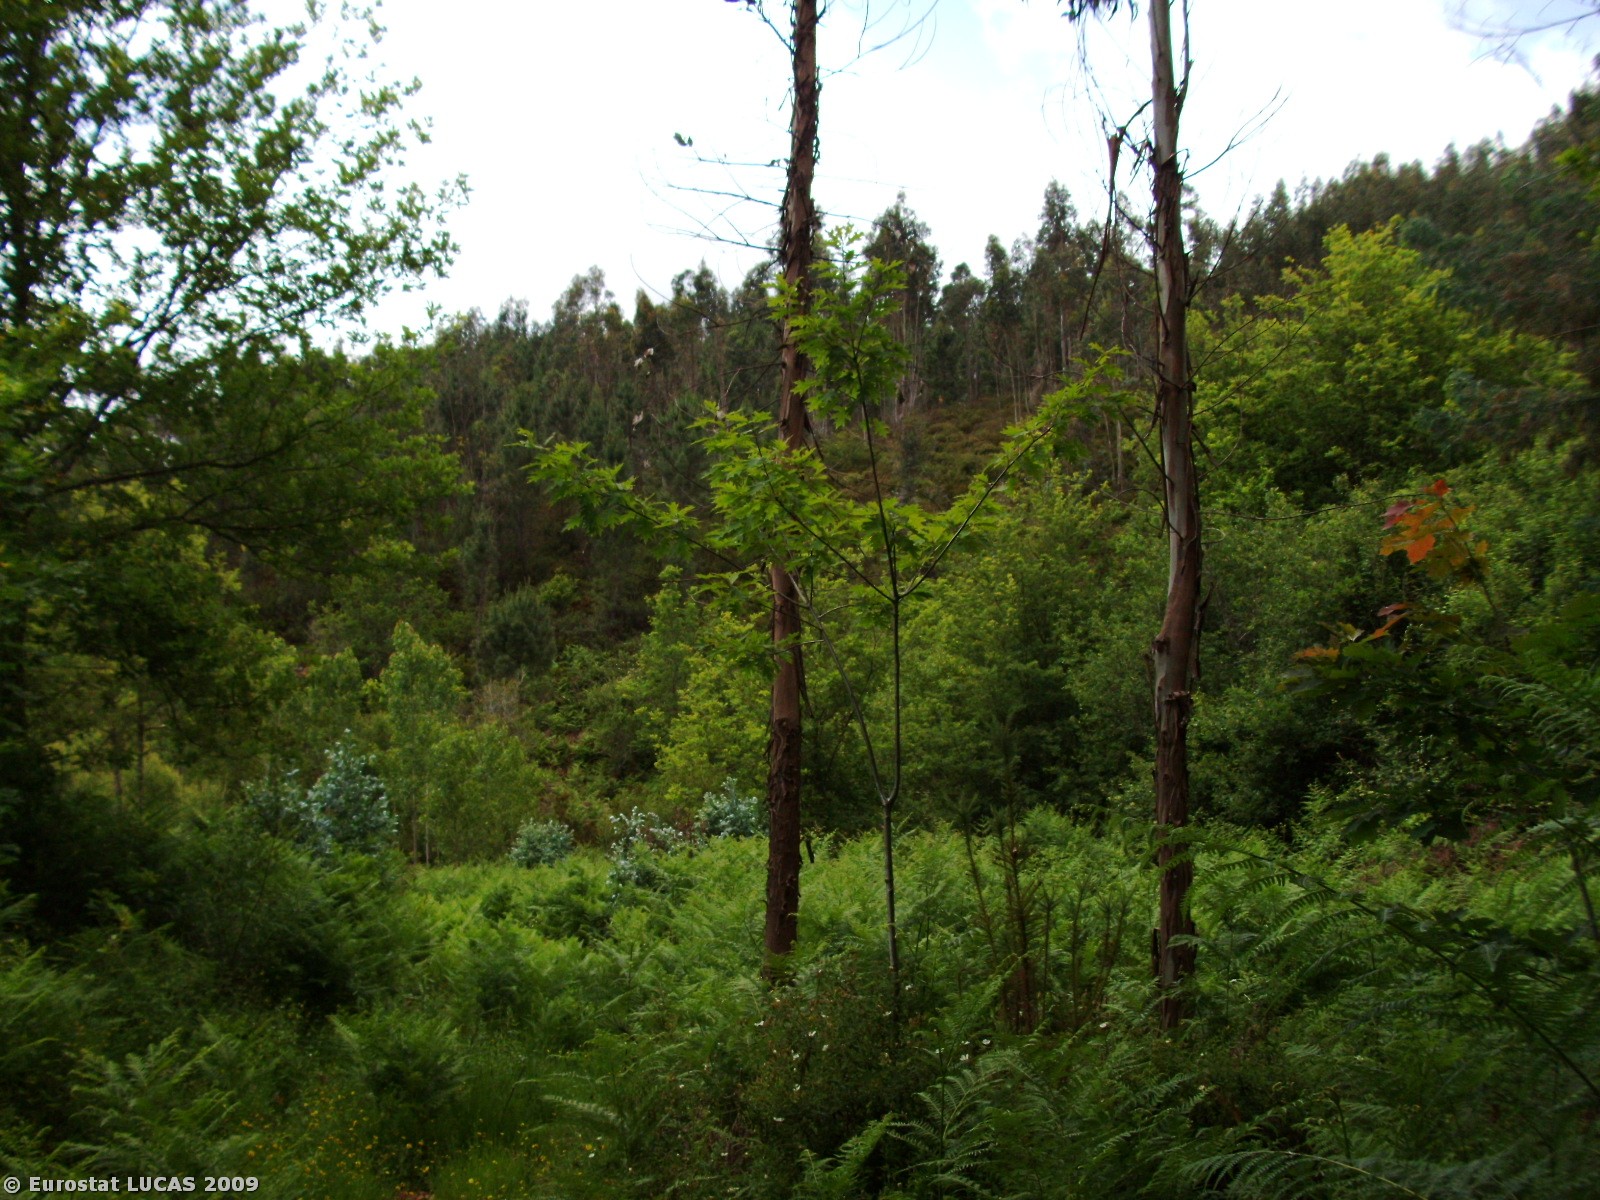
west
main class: Woodland
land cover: Broadleaved woodland
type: mesophytic deciduous forest
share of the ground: 50 - 75 %
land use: Forestry
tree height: > 5 m
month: June
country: PT
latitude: 39.9617
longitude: -8.1586
